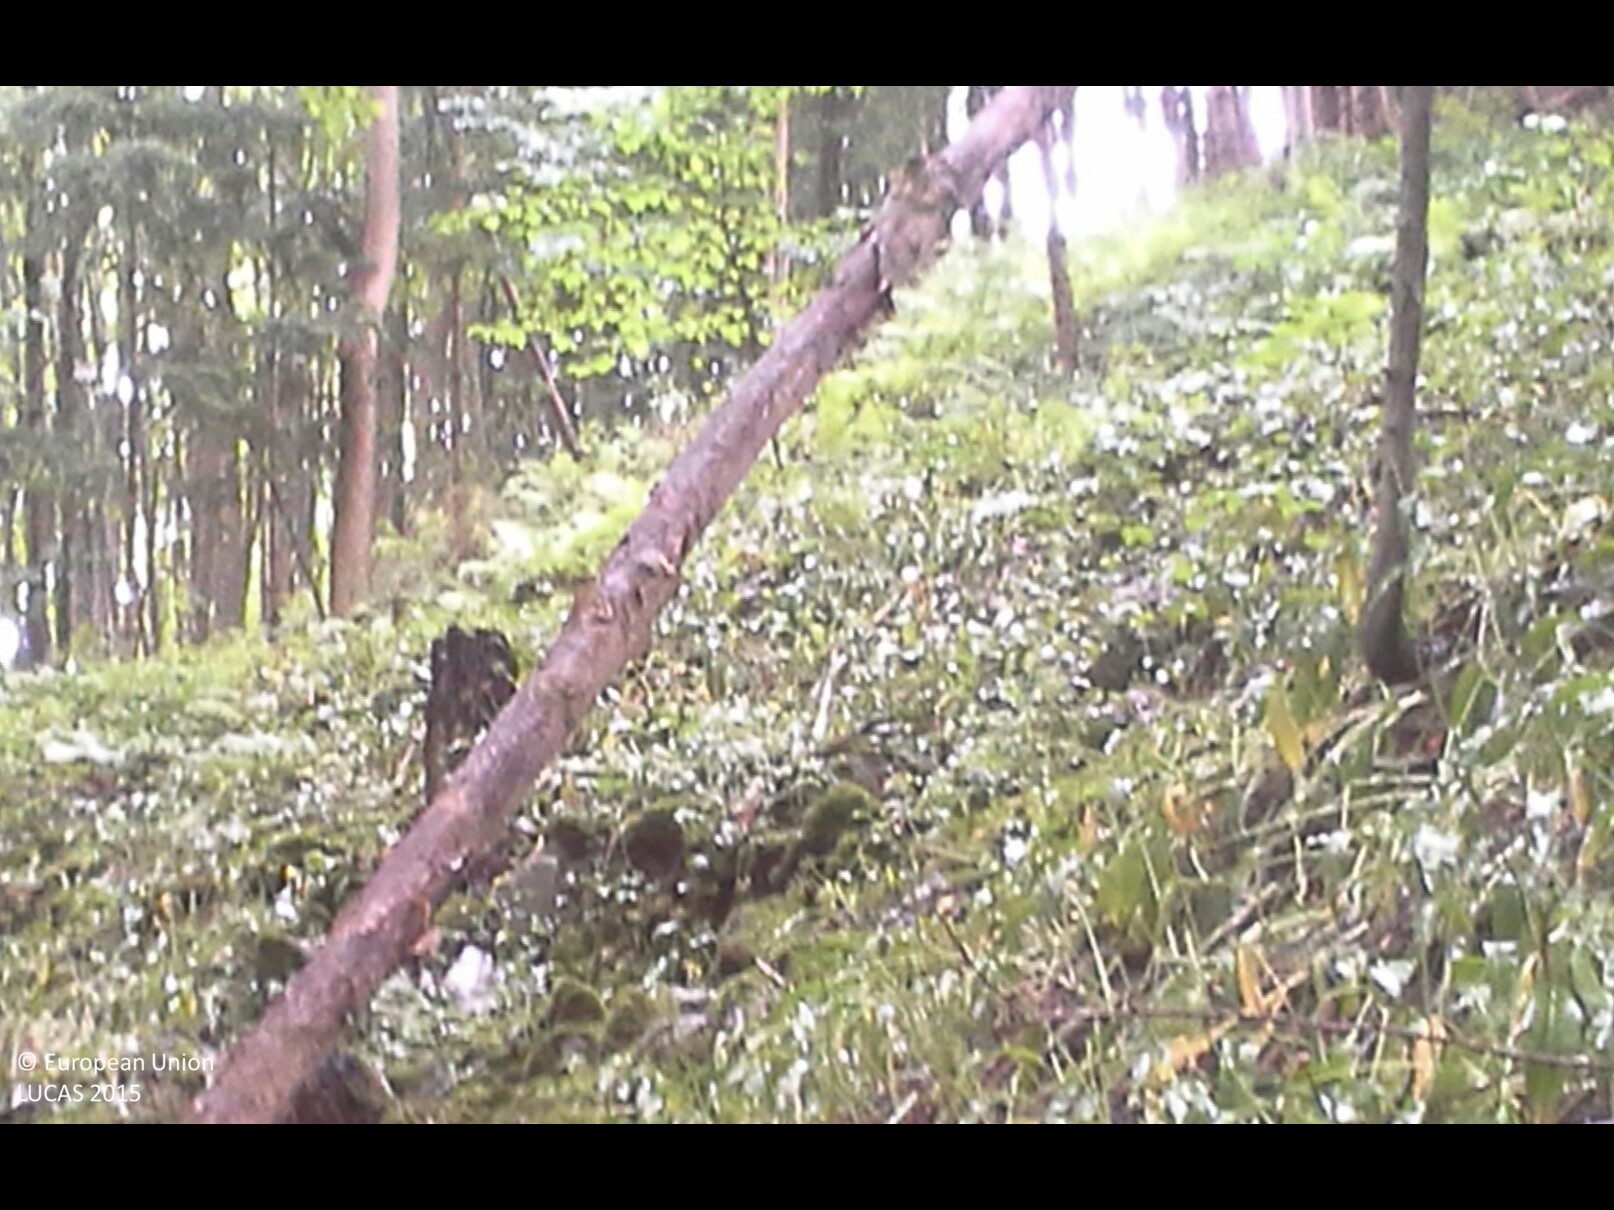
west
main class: Woodland
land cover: Broadleaved woodland
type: mesophytic deciduous forest
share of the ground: > 75 %
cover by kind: broadleaved forest trees 100 %
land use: Forestry
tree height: > 5 m
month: June
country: AT
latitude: 48.0059
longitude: 14.4904
